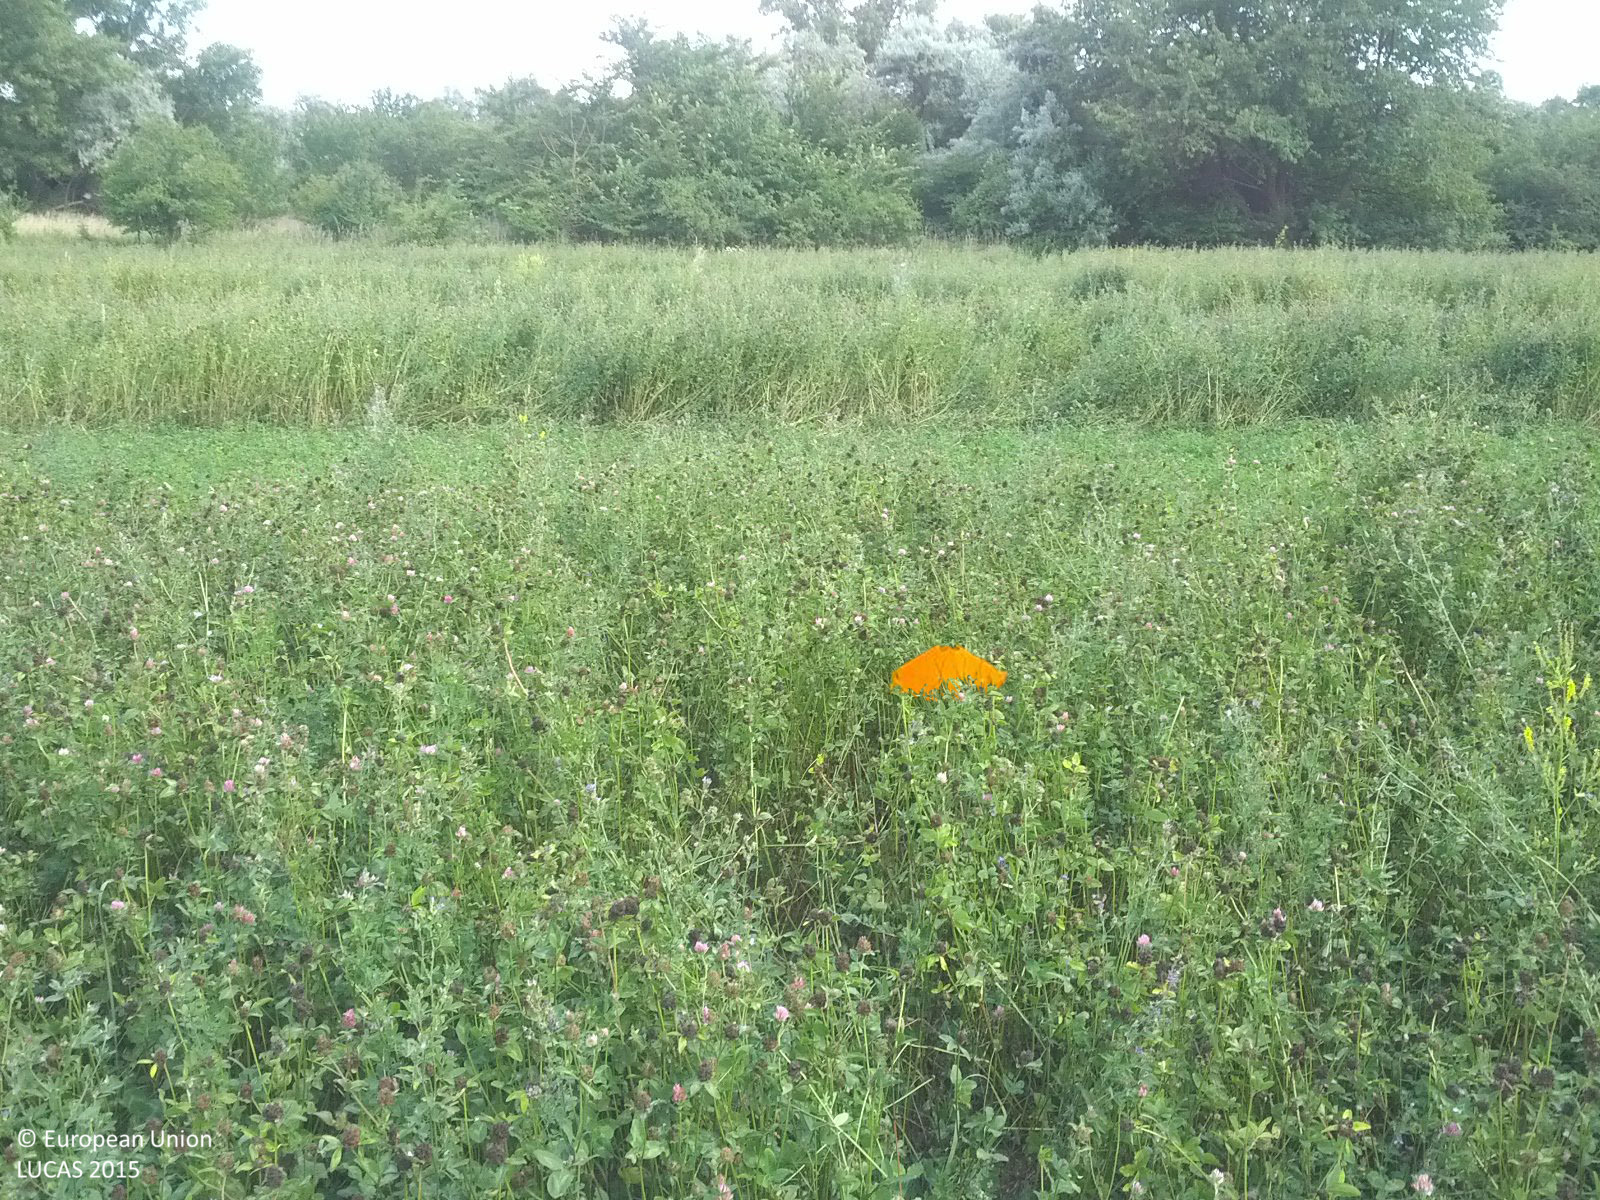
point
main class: Cropland
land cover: Clovers
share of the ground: > 75 %
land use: Agriculture (excluding fallow land and kitchen gardens)
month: June
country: AT
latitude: 48.3797
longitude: 16.7171
